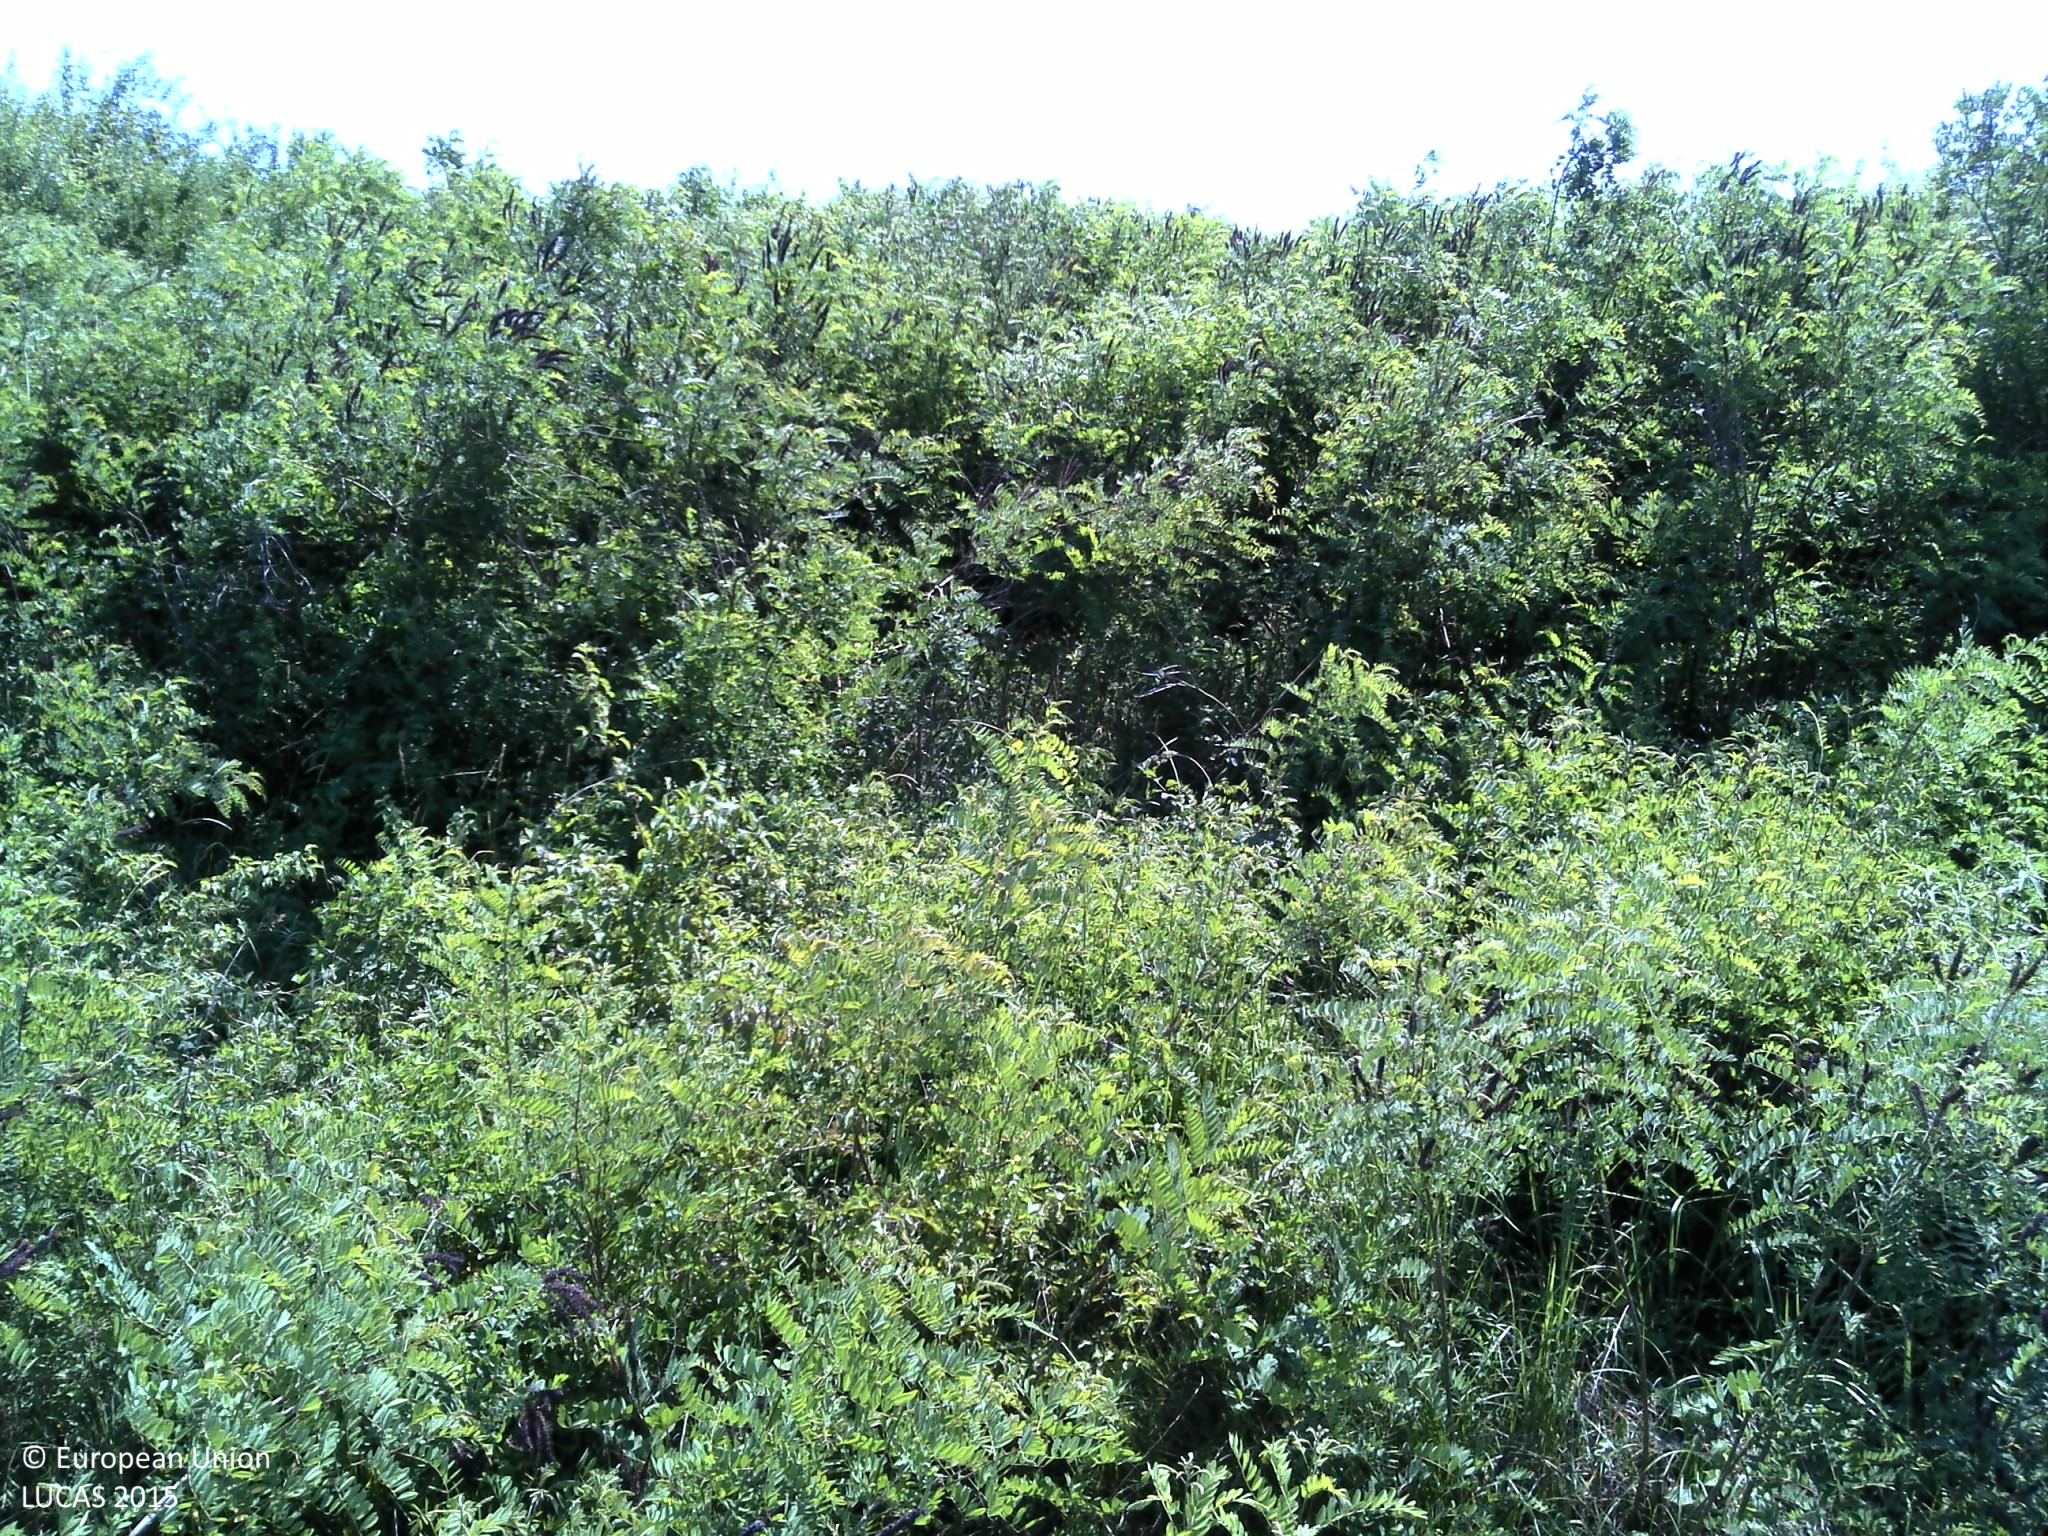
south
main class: Grassland
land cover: Spontaneously vegetated surfaces
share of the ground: > 75 %
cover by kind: herbaceous plants 100 %
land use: Fallow land
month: June
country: HR
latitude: 45.1659
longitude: 17.9794
